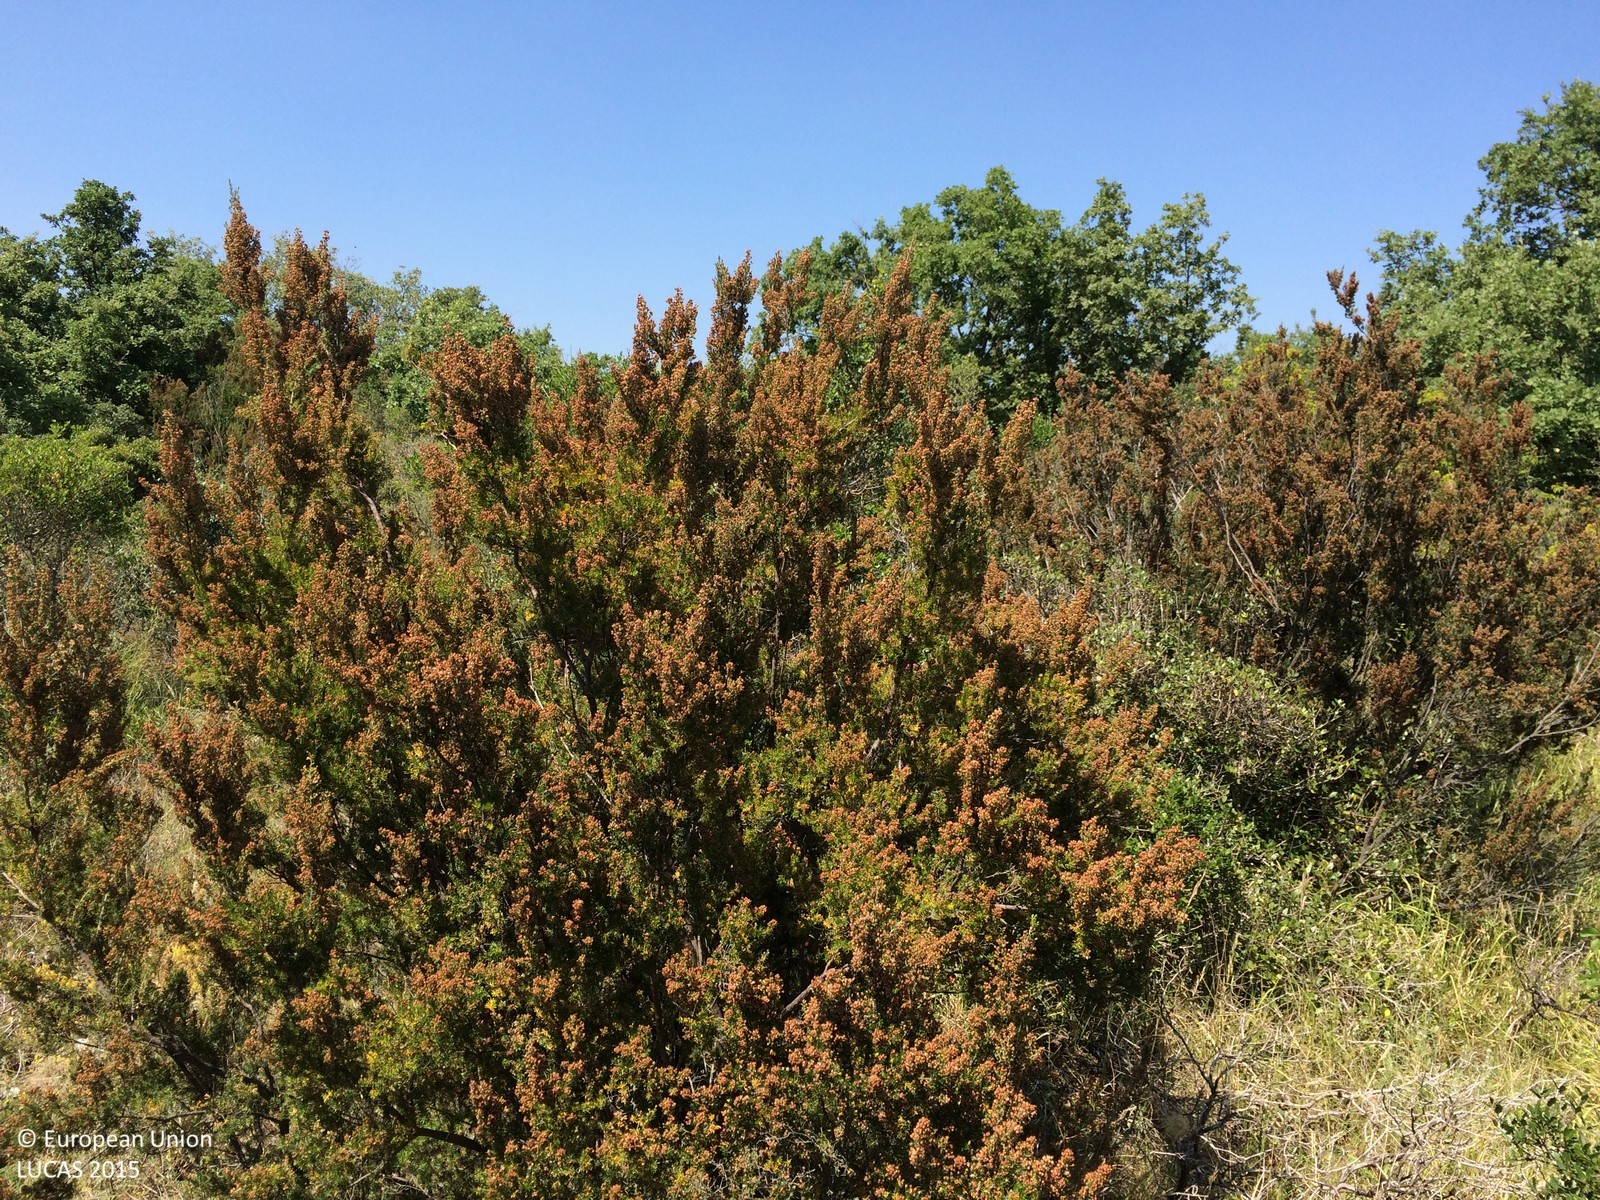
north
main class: Shrubland
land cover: Shrubland with sparse tree cover
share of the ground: > 75 %
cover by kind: shrubs 90 %, broadleaved forest trees 5 %, herbaceous plants 5 %
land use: Semi-natural and natural areas not in use
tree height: < 5 m
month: June
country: HR
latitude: 45.0025
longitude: 13.8130
